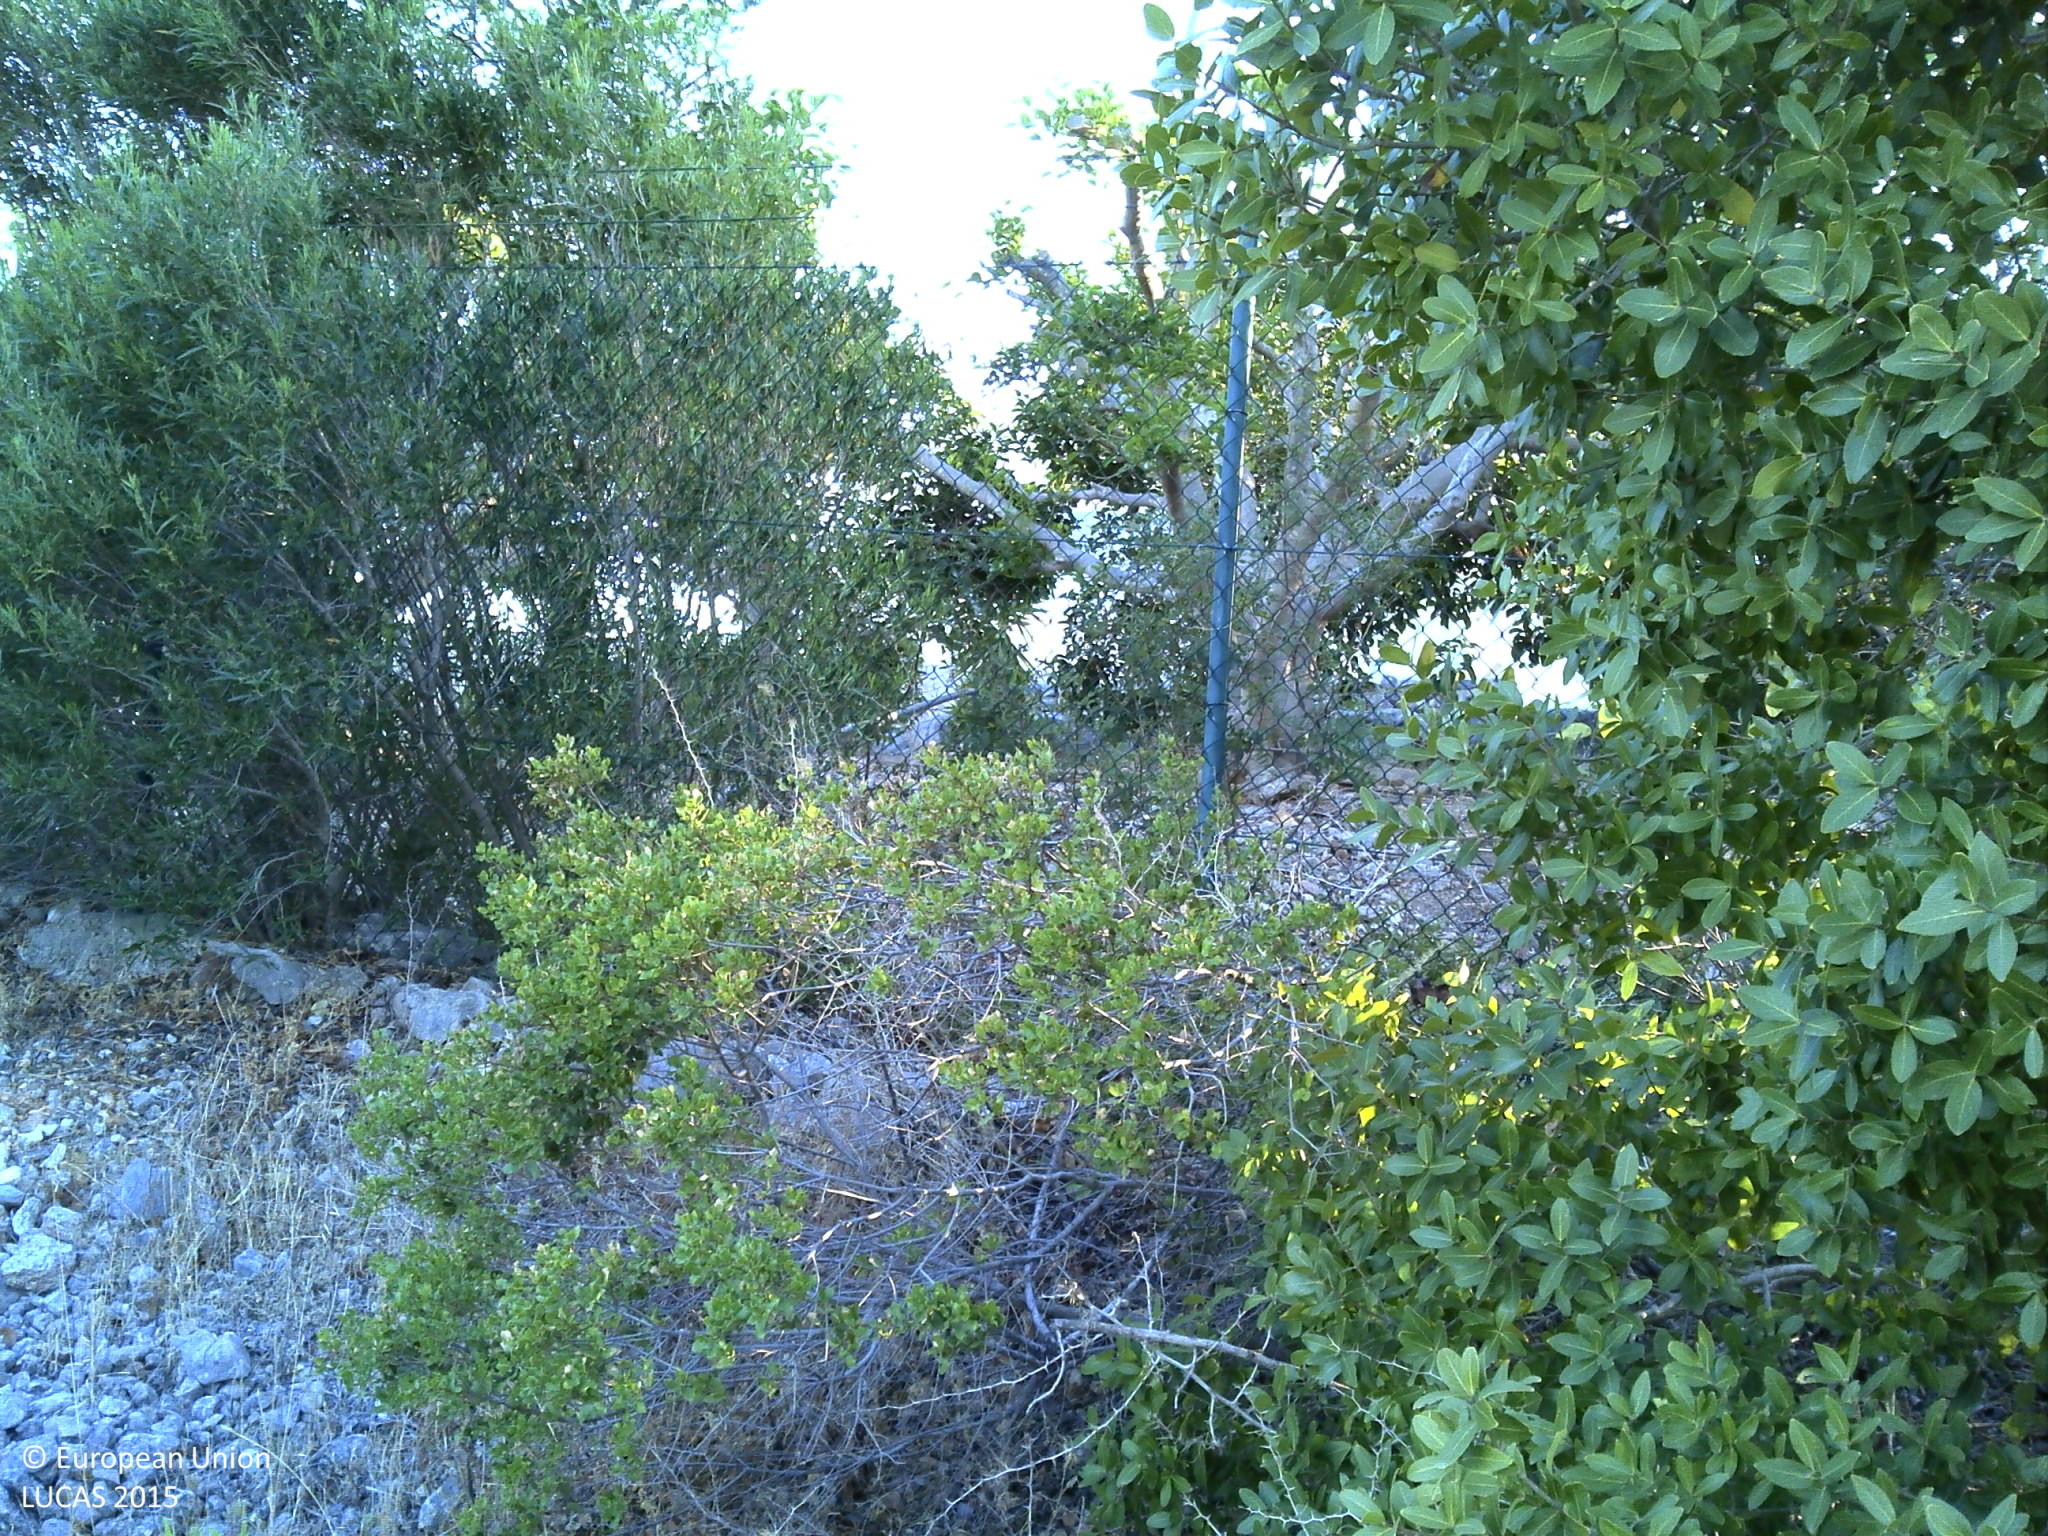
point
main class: Woodland
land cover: Broadleaved woodland
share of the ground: 25 - 50 %
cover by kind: broadleaved forest trees 40 %, unconsolidated bare surface 40 %, herbaceous plants 20 %
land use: Residential
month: June
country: PT
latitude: 37.0870
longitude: -7.8160
